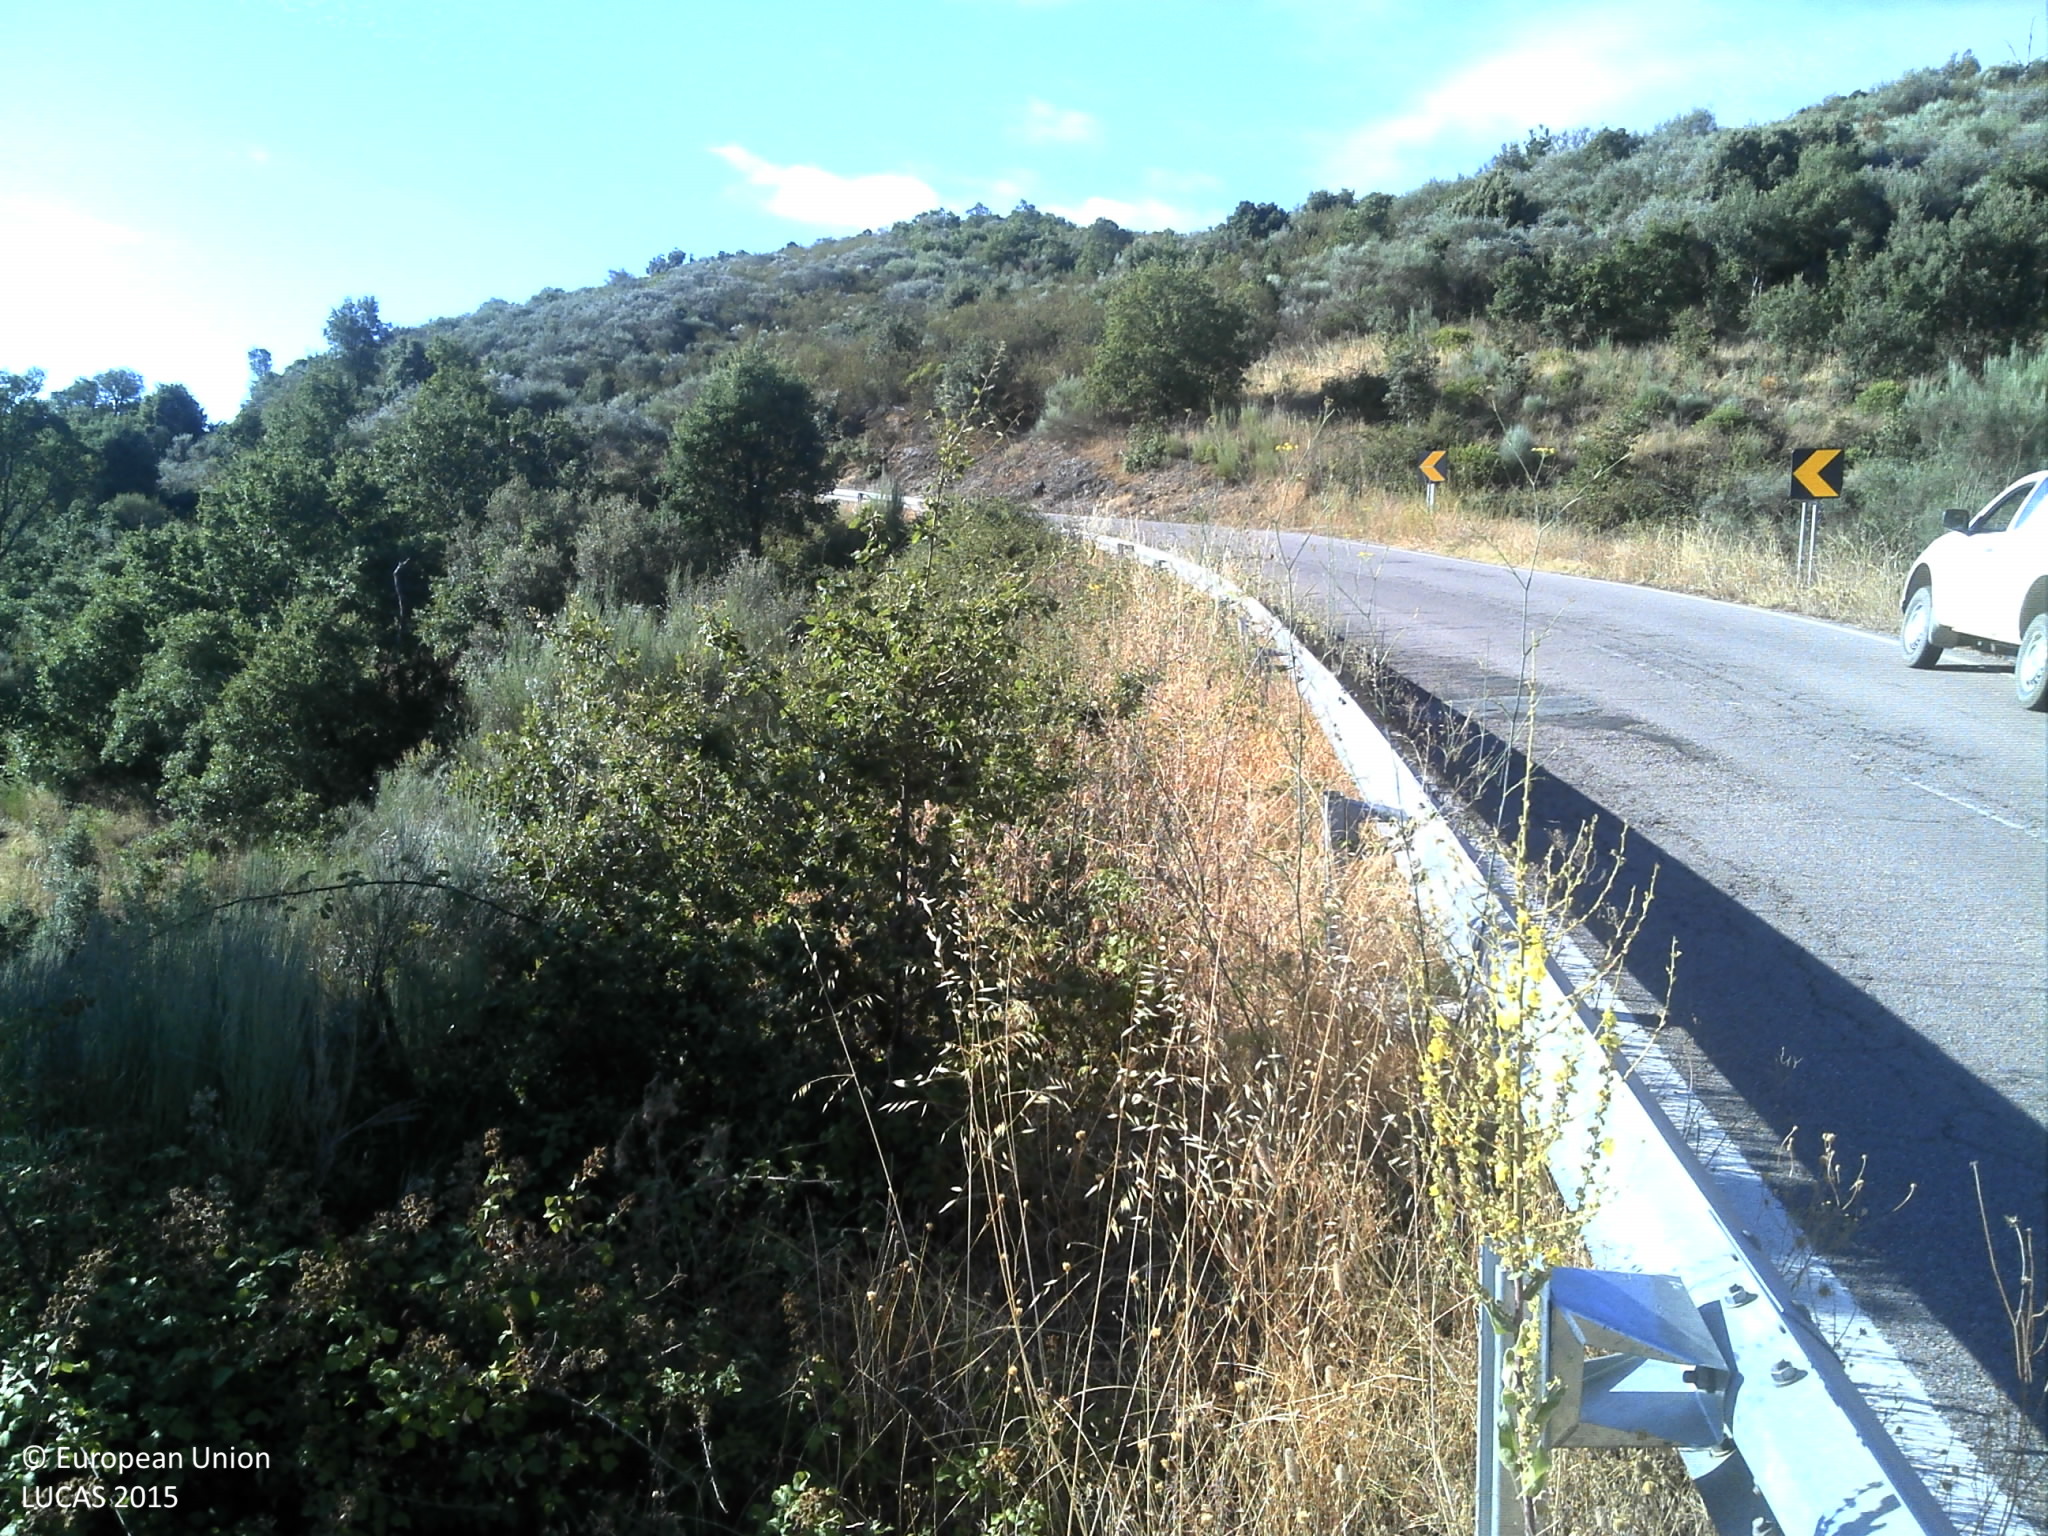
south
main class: Shrubland
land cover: Shrubland with sparse tree cover
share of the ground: > 75 %
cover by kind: shrubs 95 %, broadleaved forest trees 5 %
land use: Semi-natural and natural areas not in use
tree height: > 5 m
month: July
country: PT
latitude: 41.4098
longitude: -7.0907
